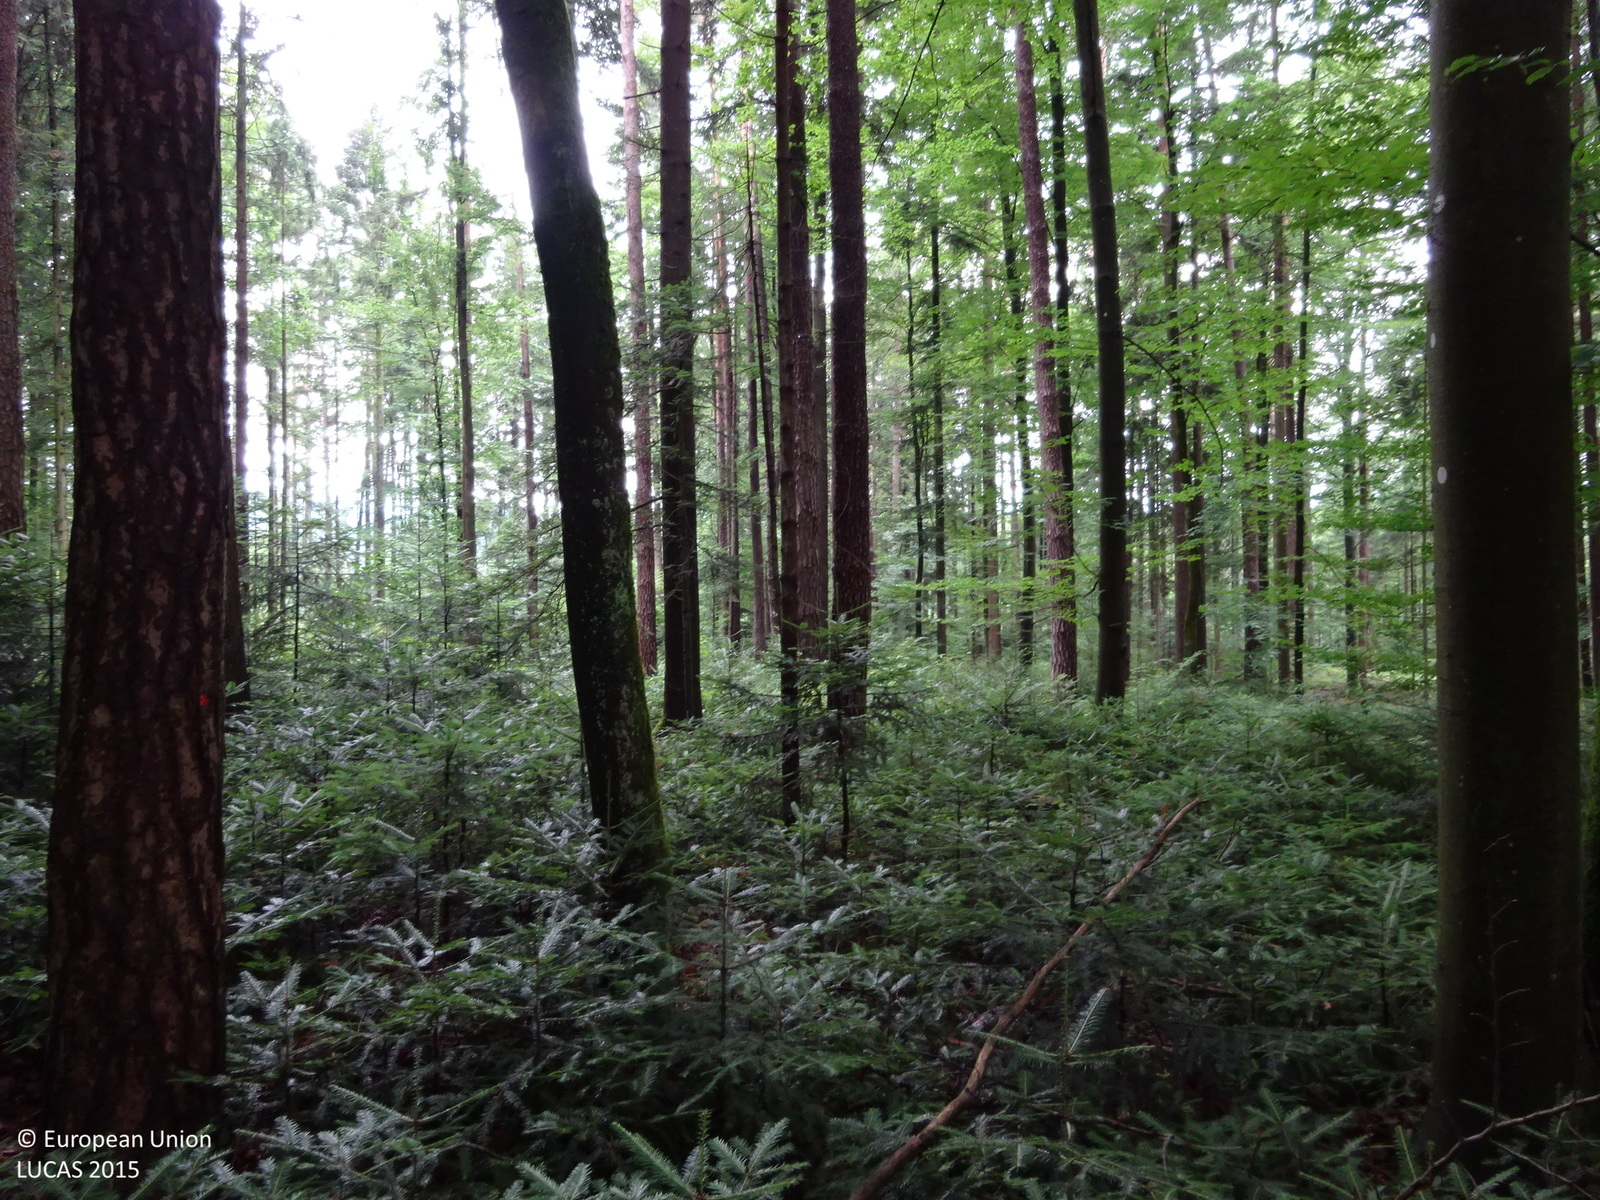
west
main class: Woodland
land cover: Pine dominated mixed woodland
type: mountainous beech forest
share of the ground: > 75 %
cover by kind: broadleaved forest trees 70 %, coniferous forest trees 30 %
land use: Forestry
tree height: > 5 m
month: June
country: AT
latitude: 46.7099
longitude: 15.2440
